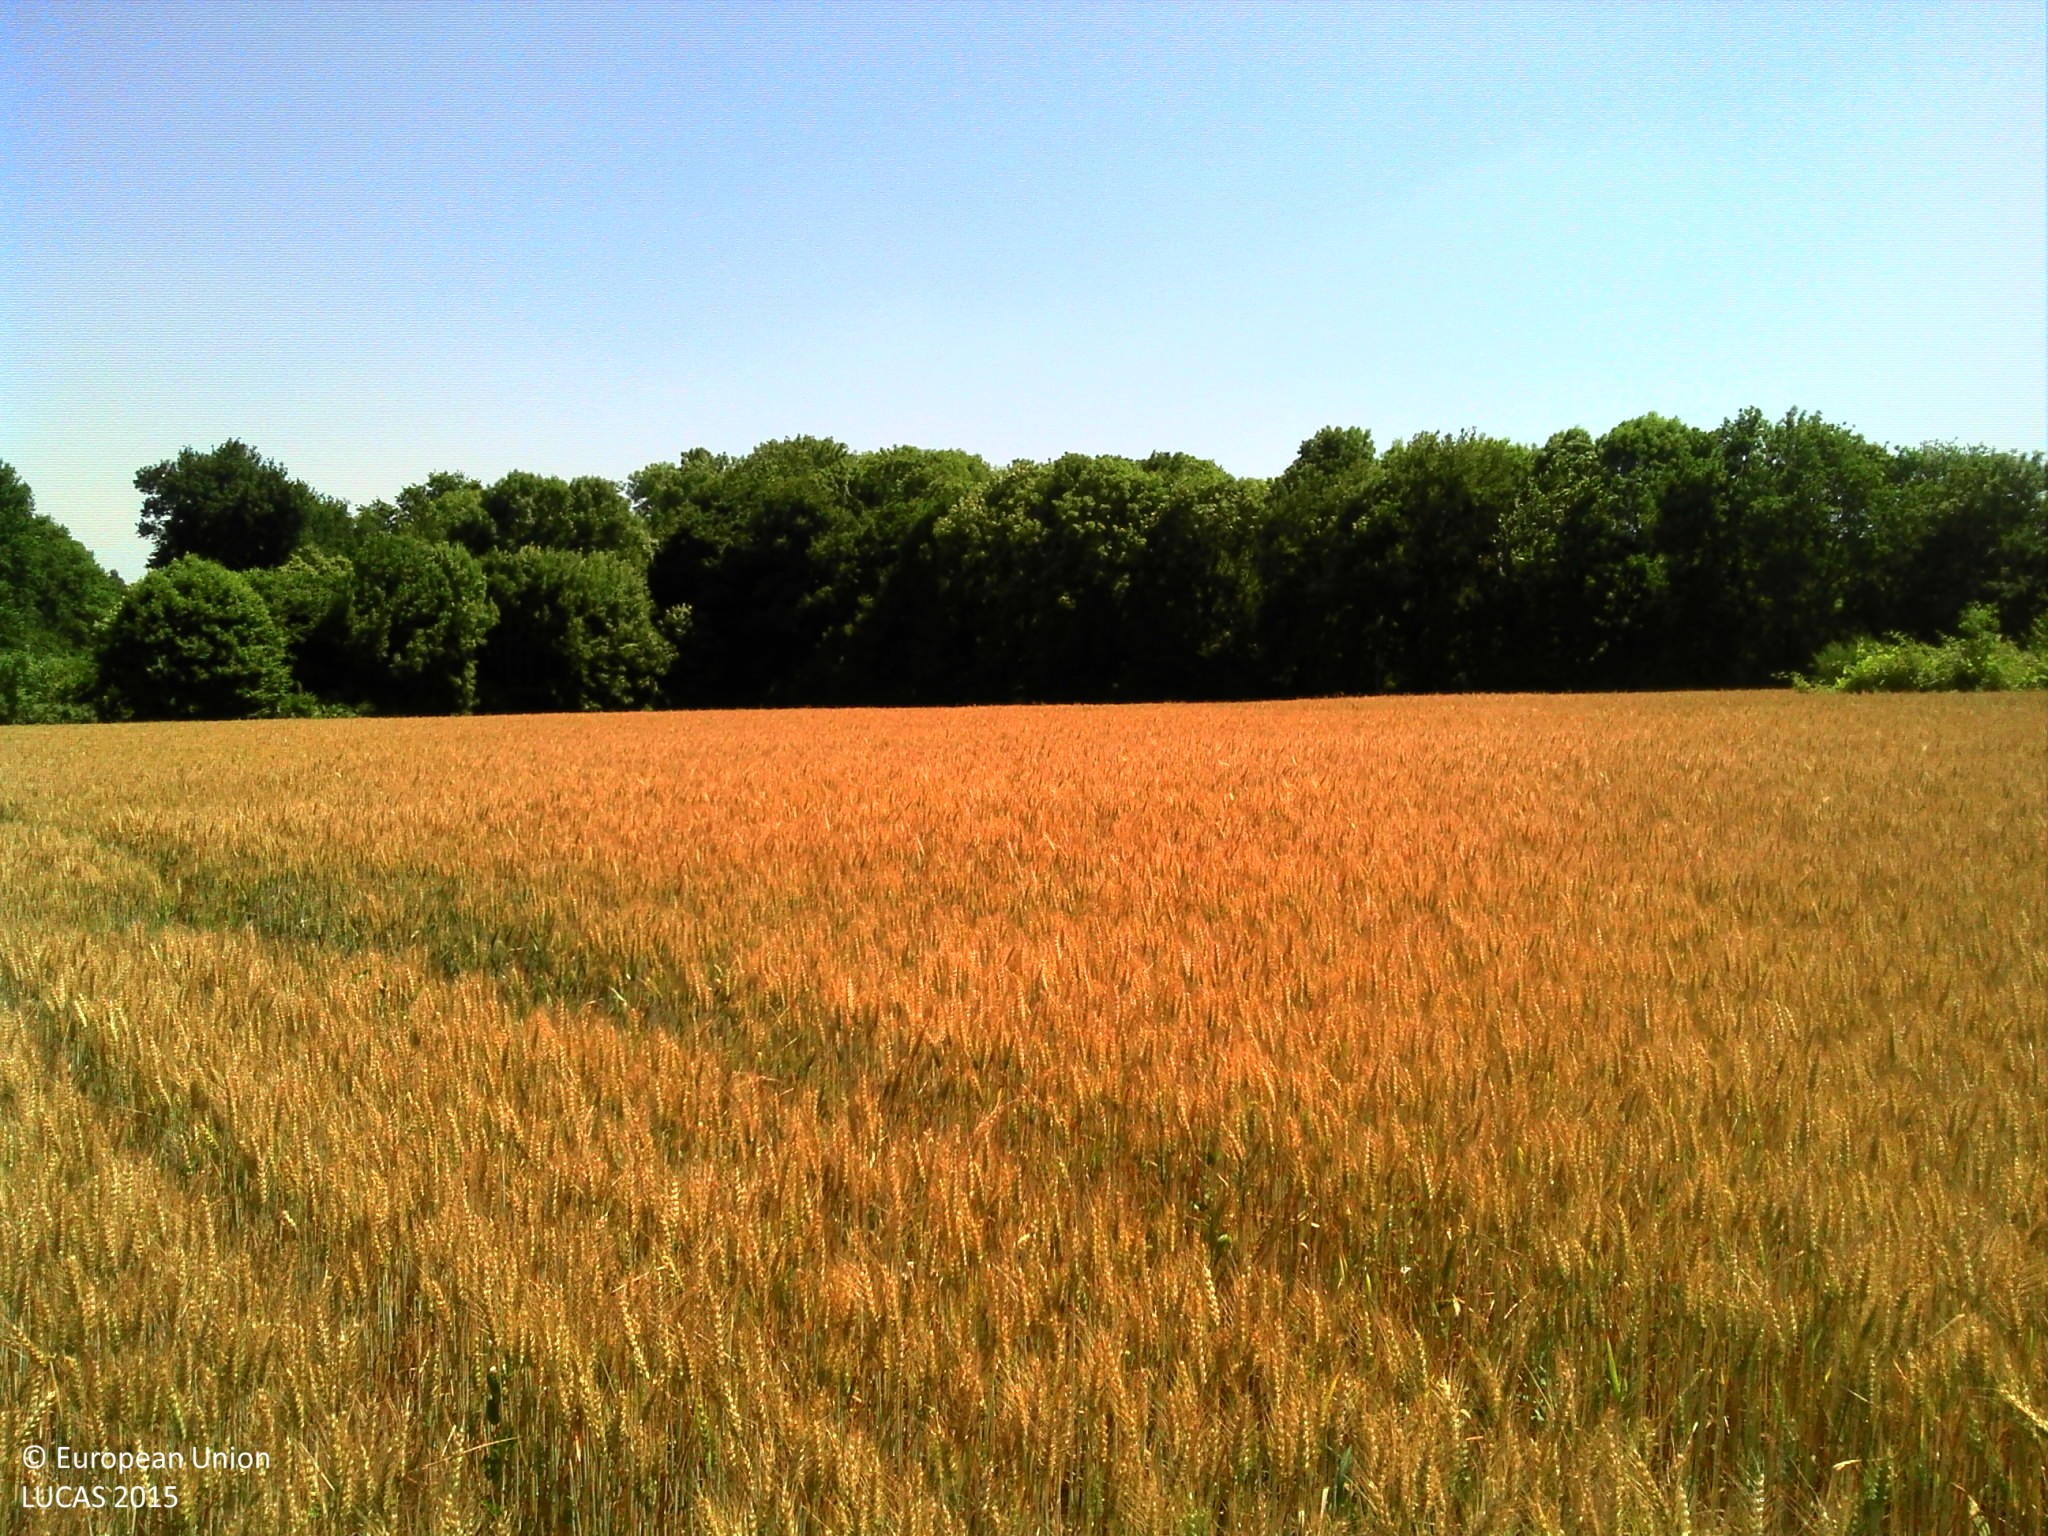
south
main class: Cropland
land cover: Common wheat
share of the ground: > 75 %
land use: Agriculture (excluding fallow land and kitchen gardens)
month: June
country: FR
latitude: 45.8970
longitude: 0.5642
